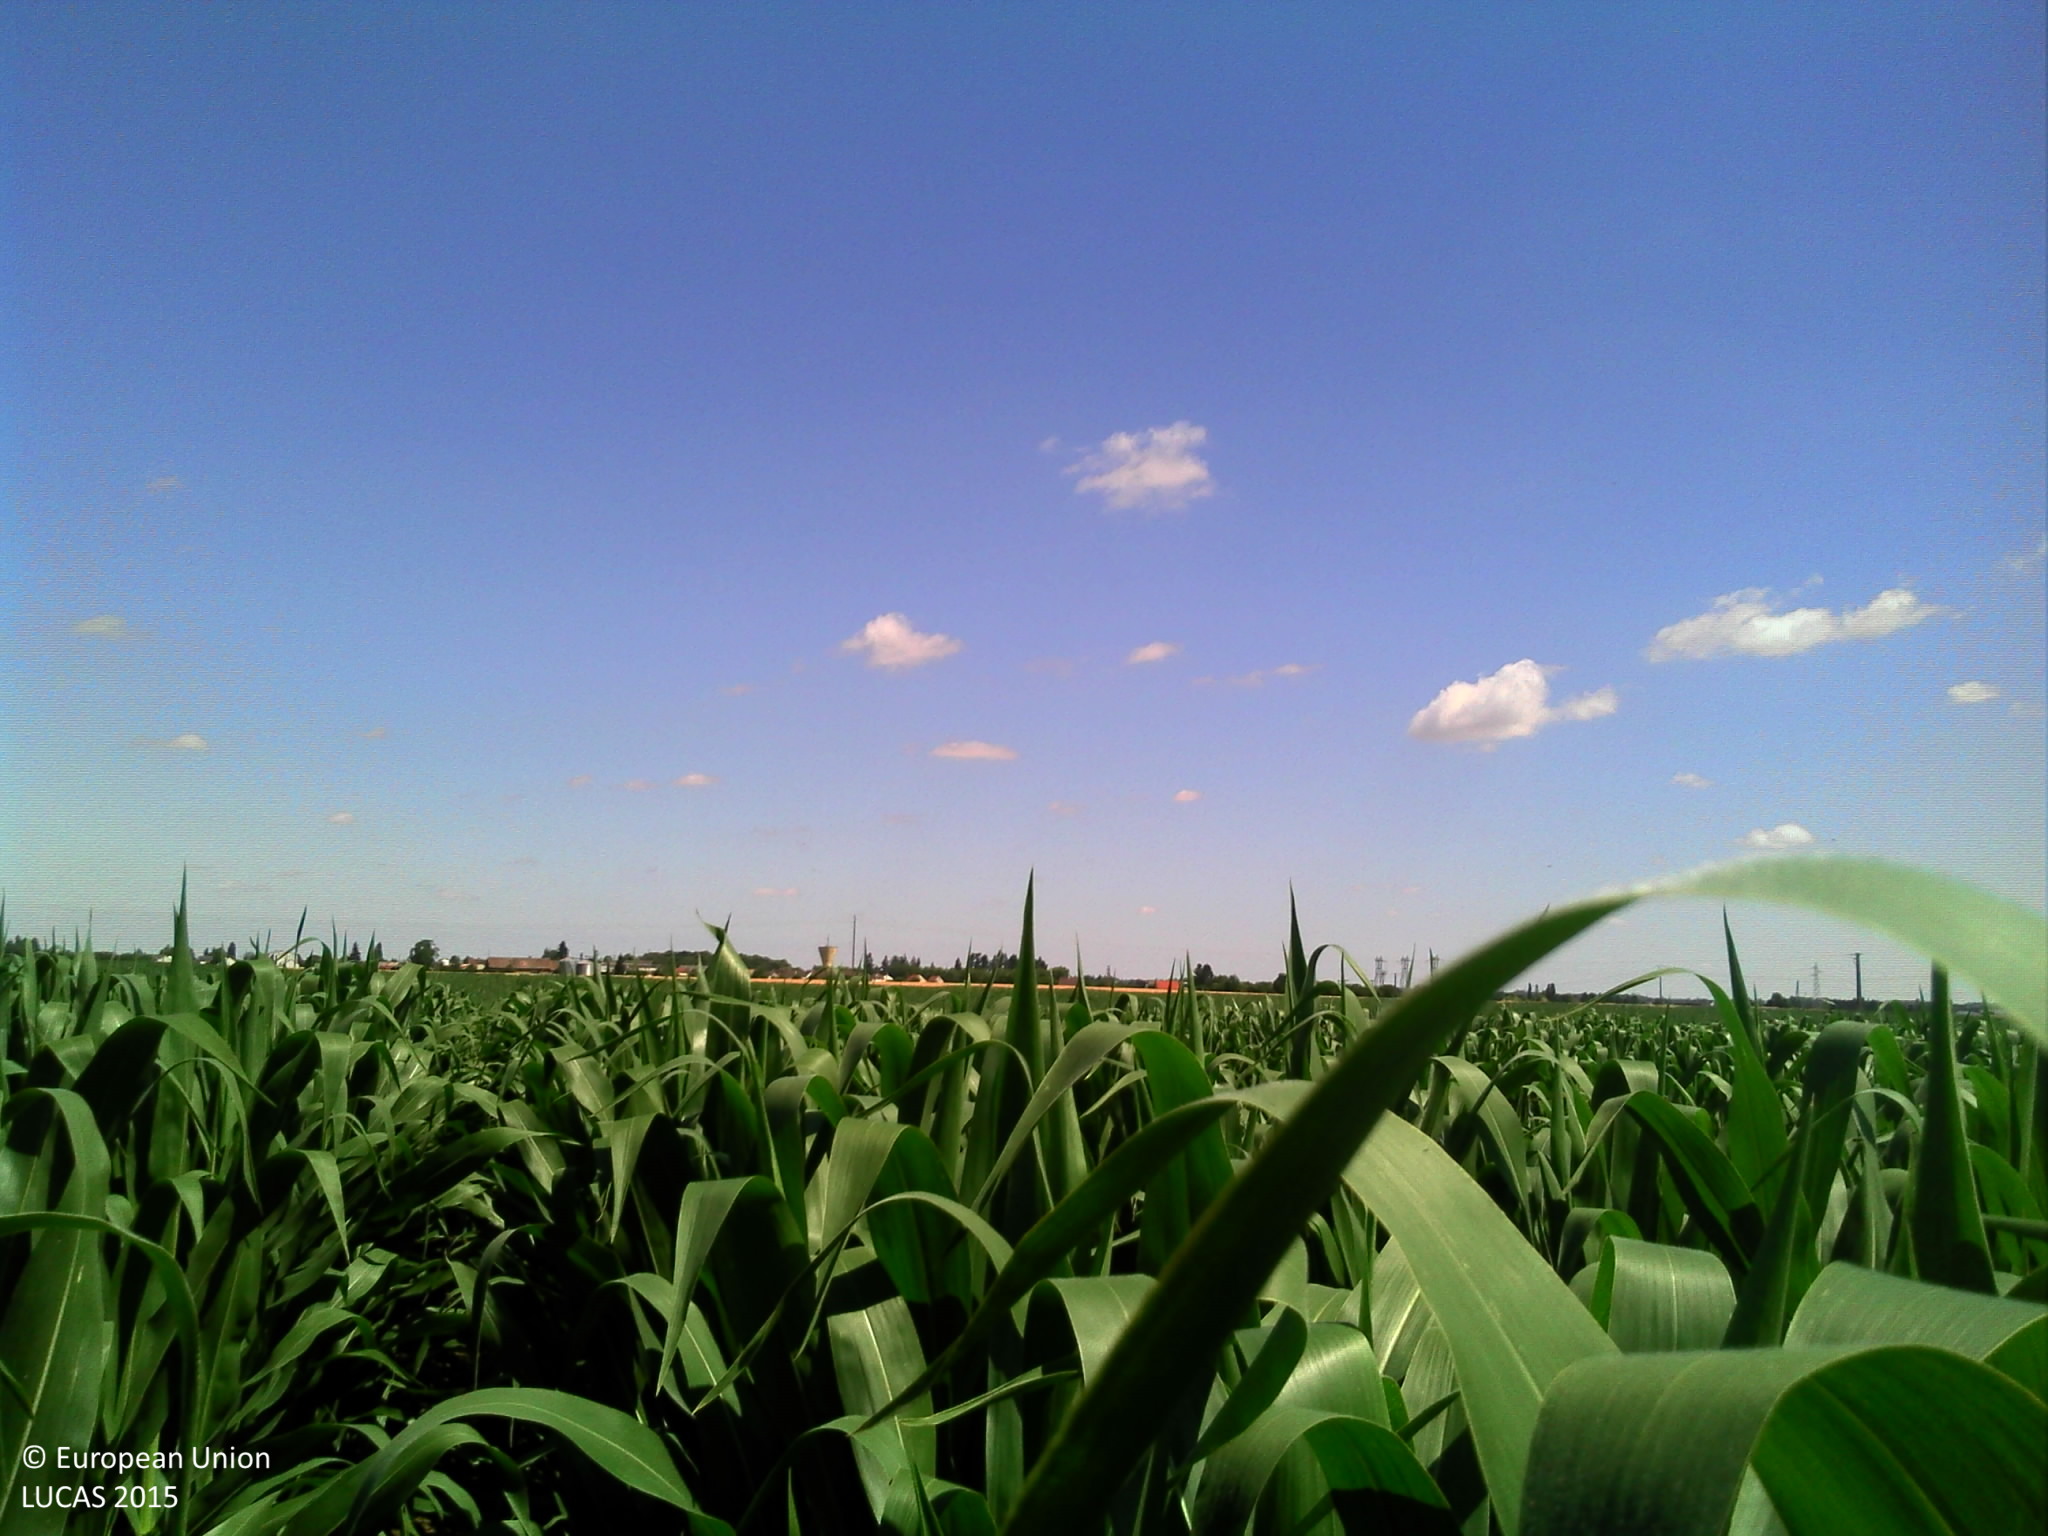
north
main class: Cropland
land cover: Maize
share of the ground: > 75 %
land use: Agriculture (excluding fallow land and kitchen gardens)
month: July
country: FR
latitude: 48.0229
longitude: 3.0610
